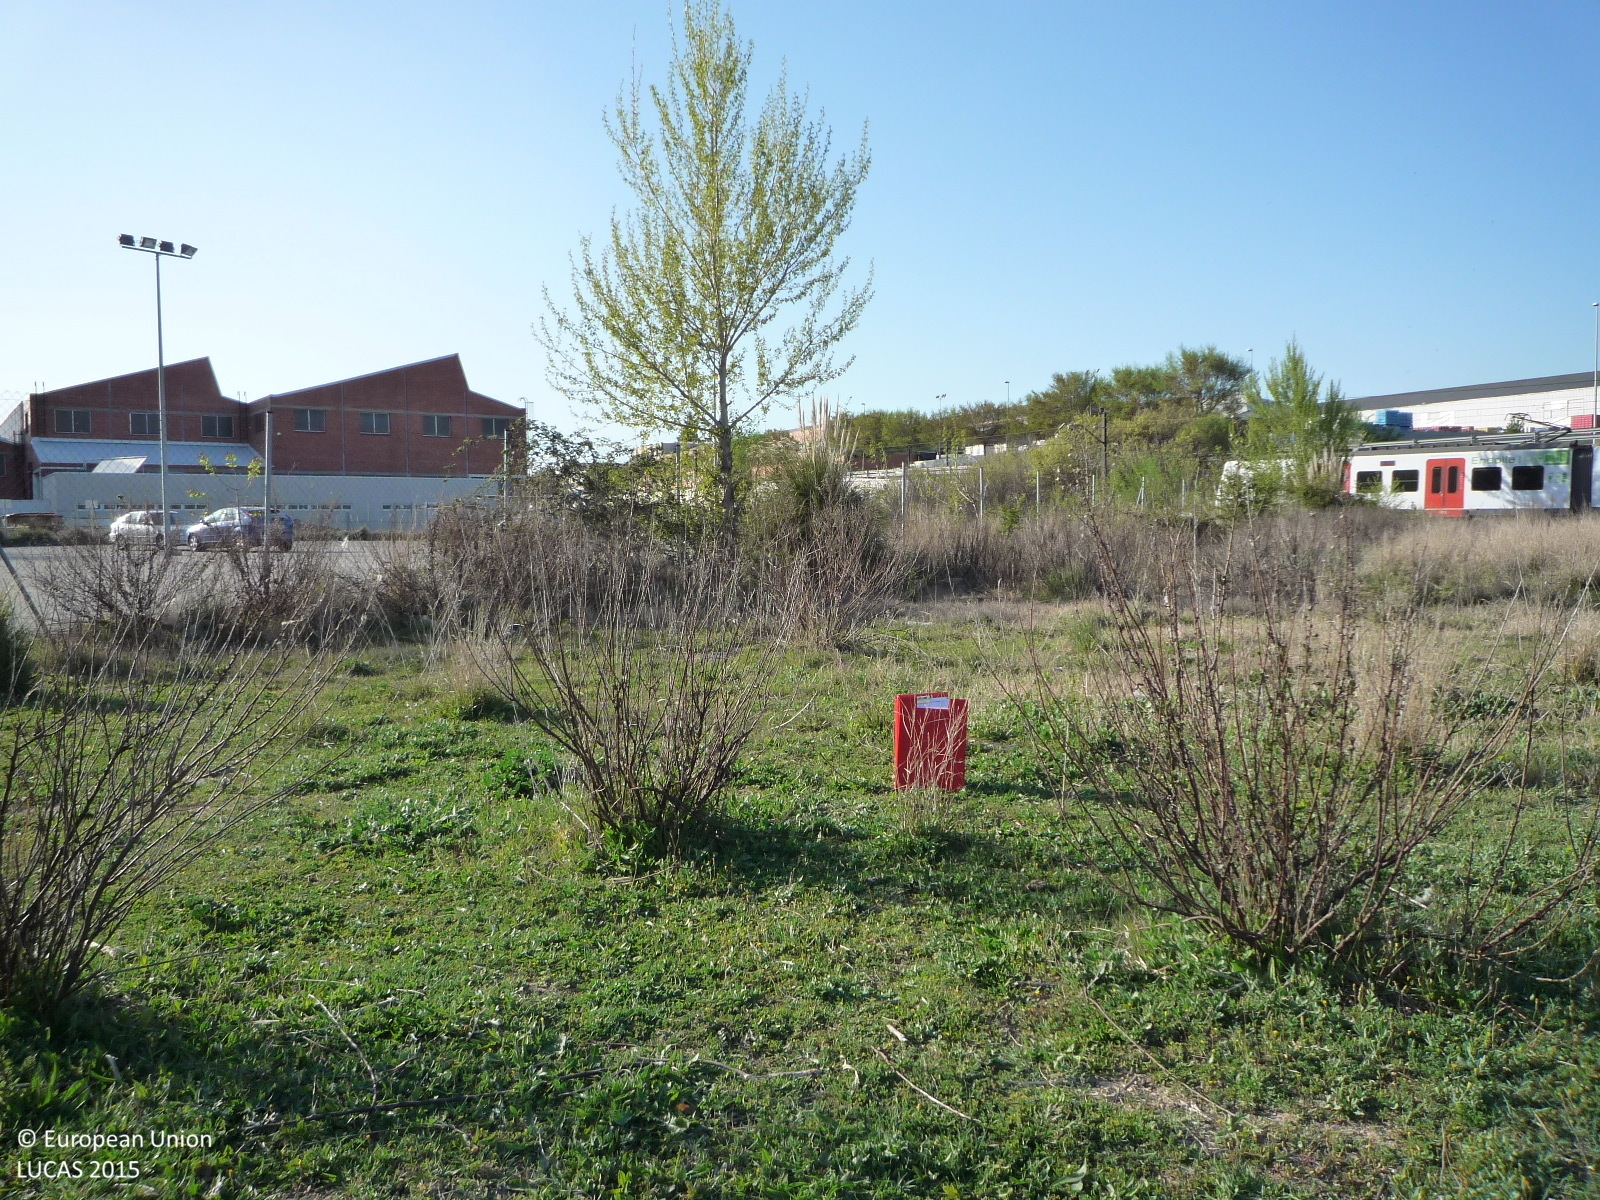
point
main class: Grassland
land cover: Grassland without tree/shrub cover
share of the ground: > 75 %
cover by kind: herbaceous plants 95 %, shrubs 5 %
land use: Abandoned areas
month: April
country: ES
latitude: 41.5651
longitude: 1.6577
